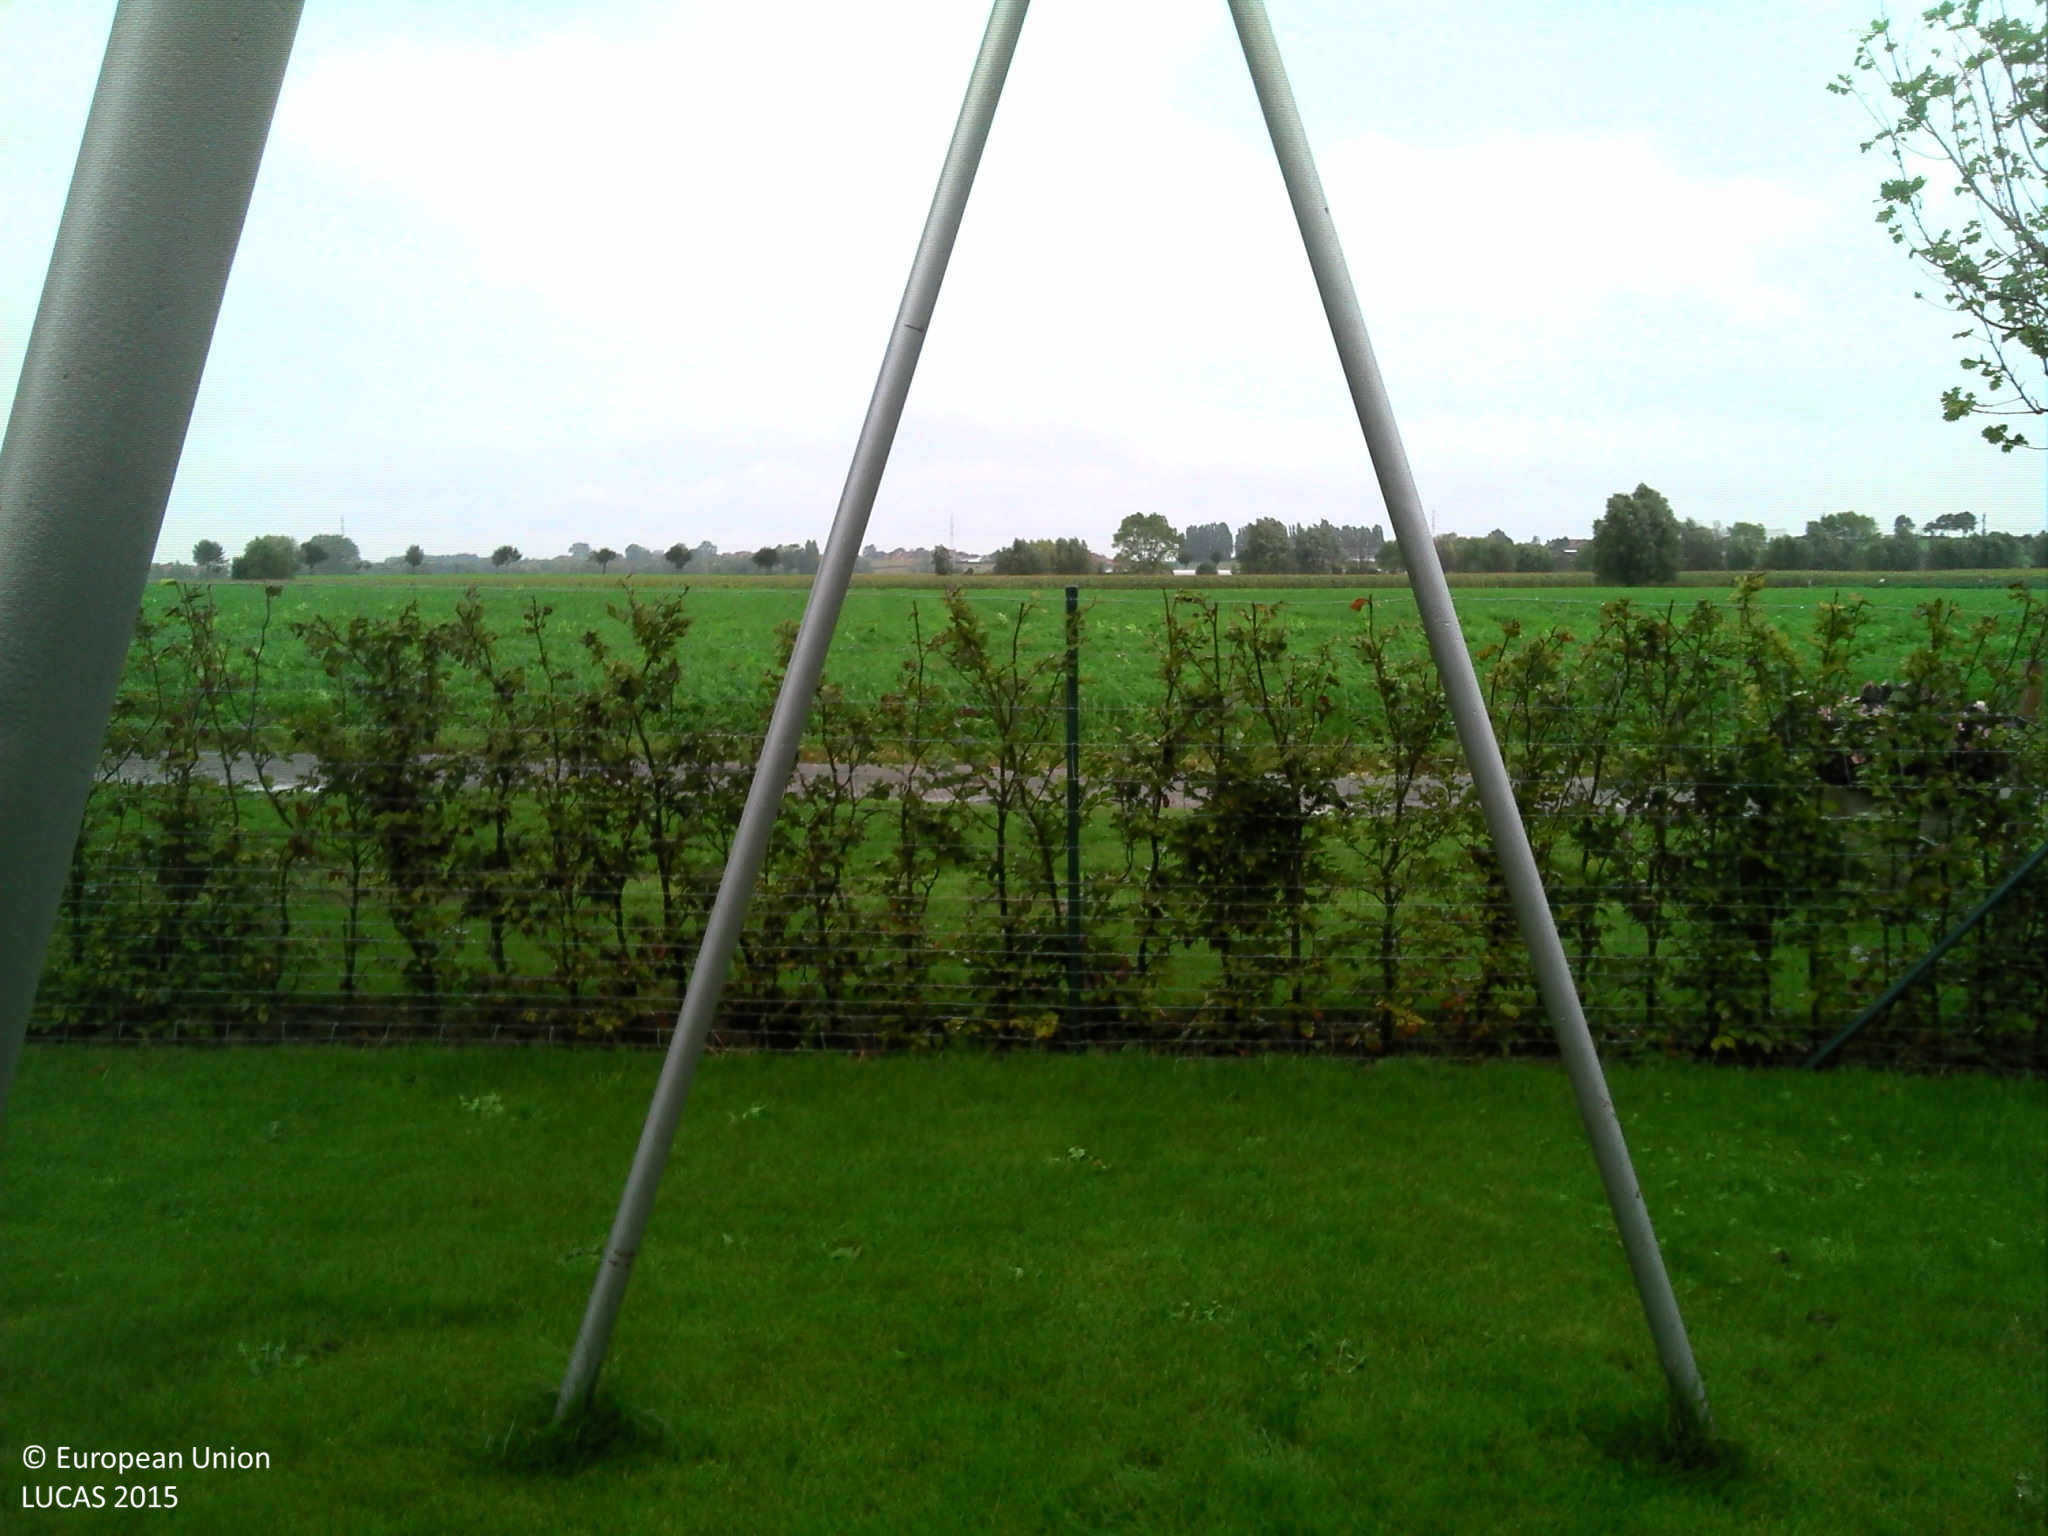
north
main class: Grassland
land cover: Grassland without tree/shrub cover
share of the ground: > 75 %
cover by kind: herbaceous plants 100 %
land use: Residential
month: October
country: BE
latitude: 50.9438
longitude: 3.0018
